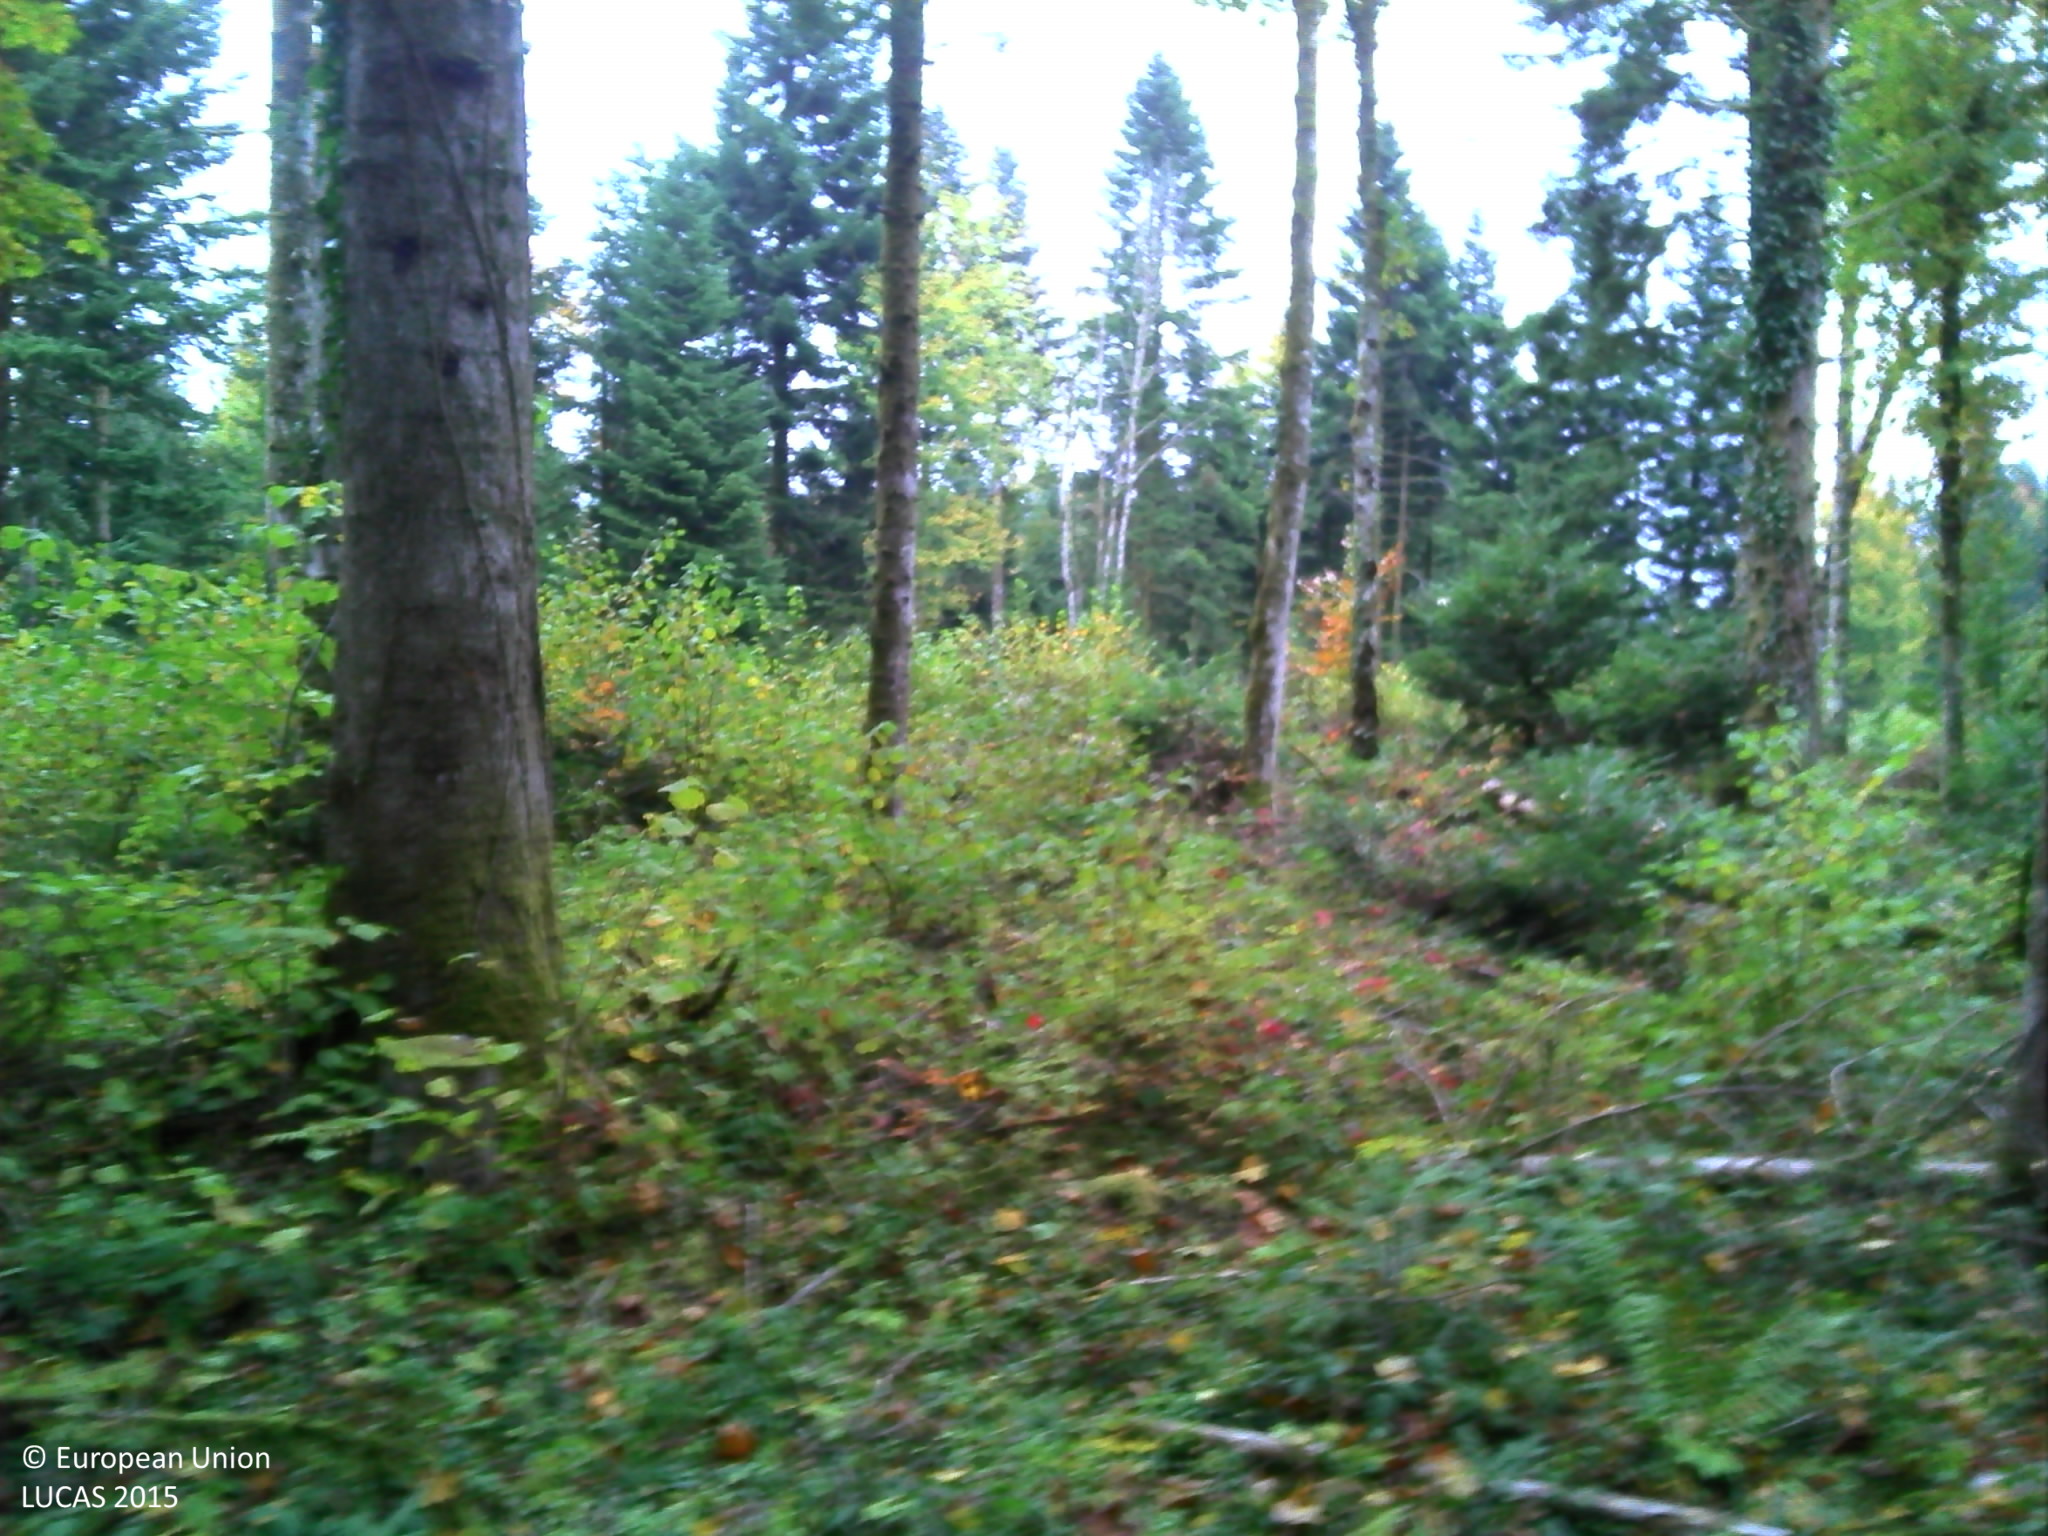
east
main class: Woodland
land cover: Spruce dominated mixed woodland
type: mountainous beech forest
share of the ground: > 75 %
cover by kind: coniferous forest trees 45 %, broadleaved forest trees 30 %, shrubs 15 %, herbaceous plants 10 %
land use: Forestry
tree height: > 5 m
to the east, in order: Spruce dominated mixed woodland; Spontaneously vegetated surfaces; Paved roads, cycling and walking lanes; Spontaneously vegetated surfaces; Spruce dominated mixed woodland; Tracks; Spruce dominated mixed woodland; Tracks; Spruce dominated mixed woodland
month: October
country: FR
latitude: 46.9273
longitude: 6.0491
